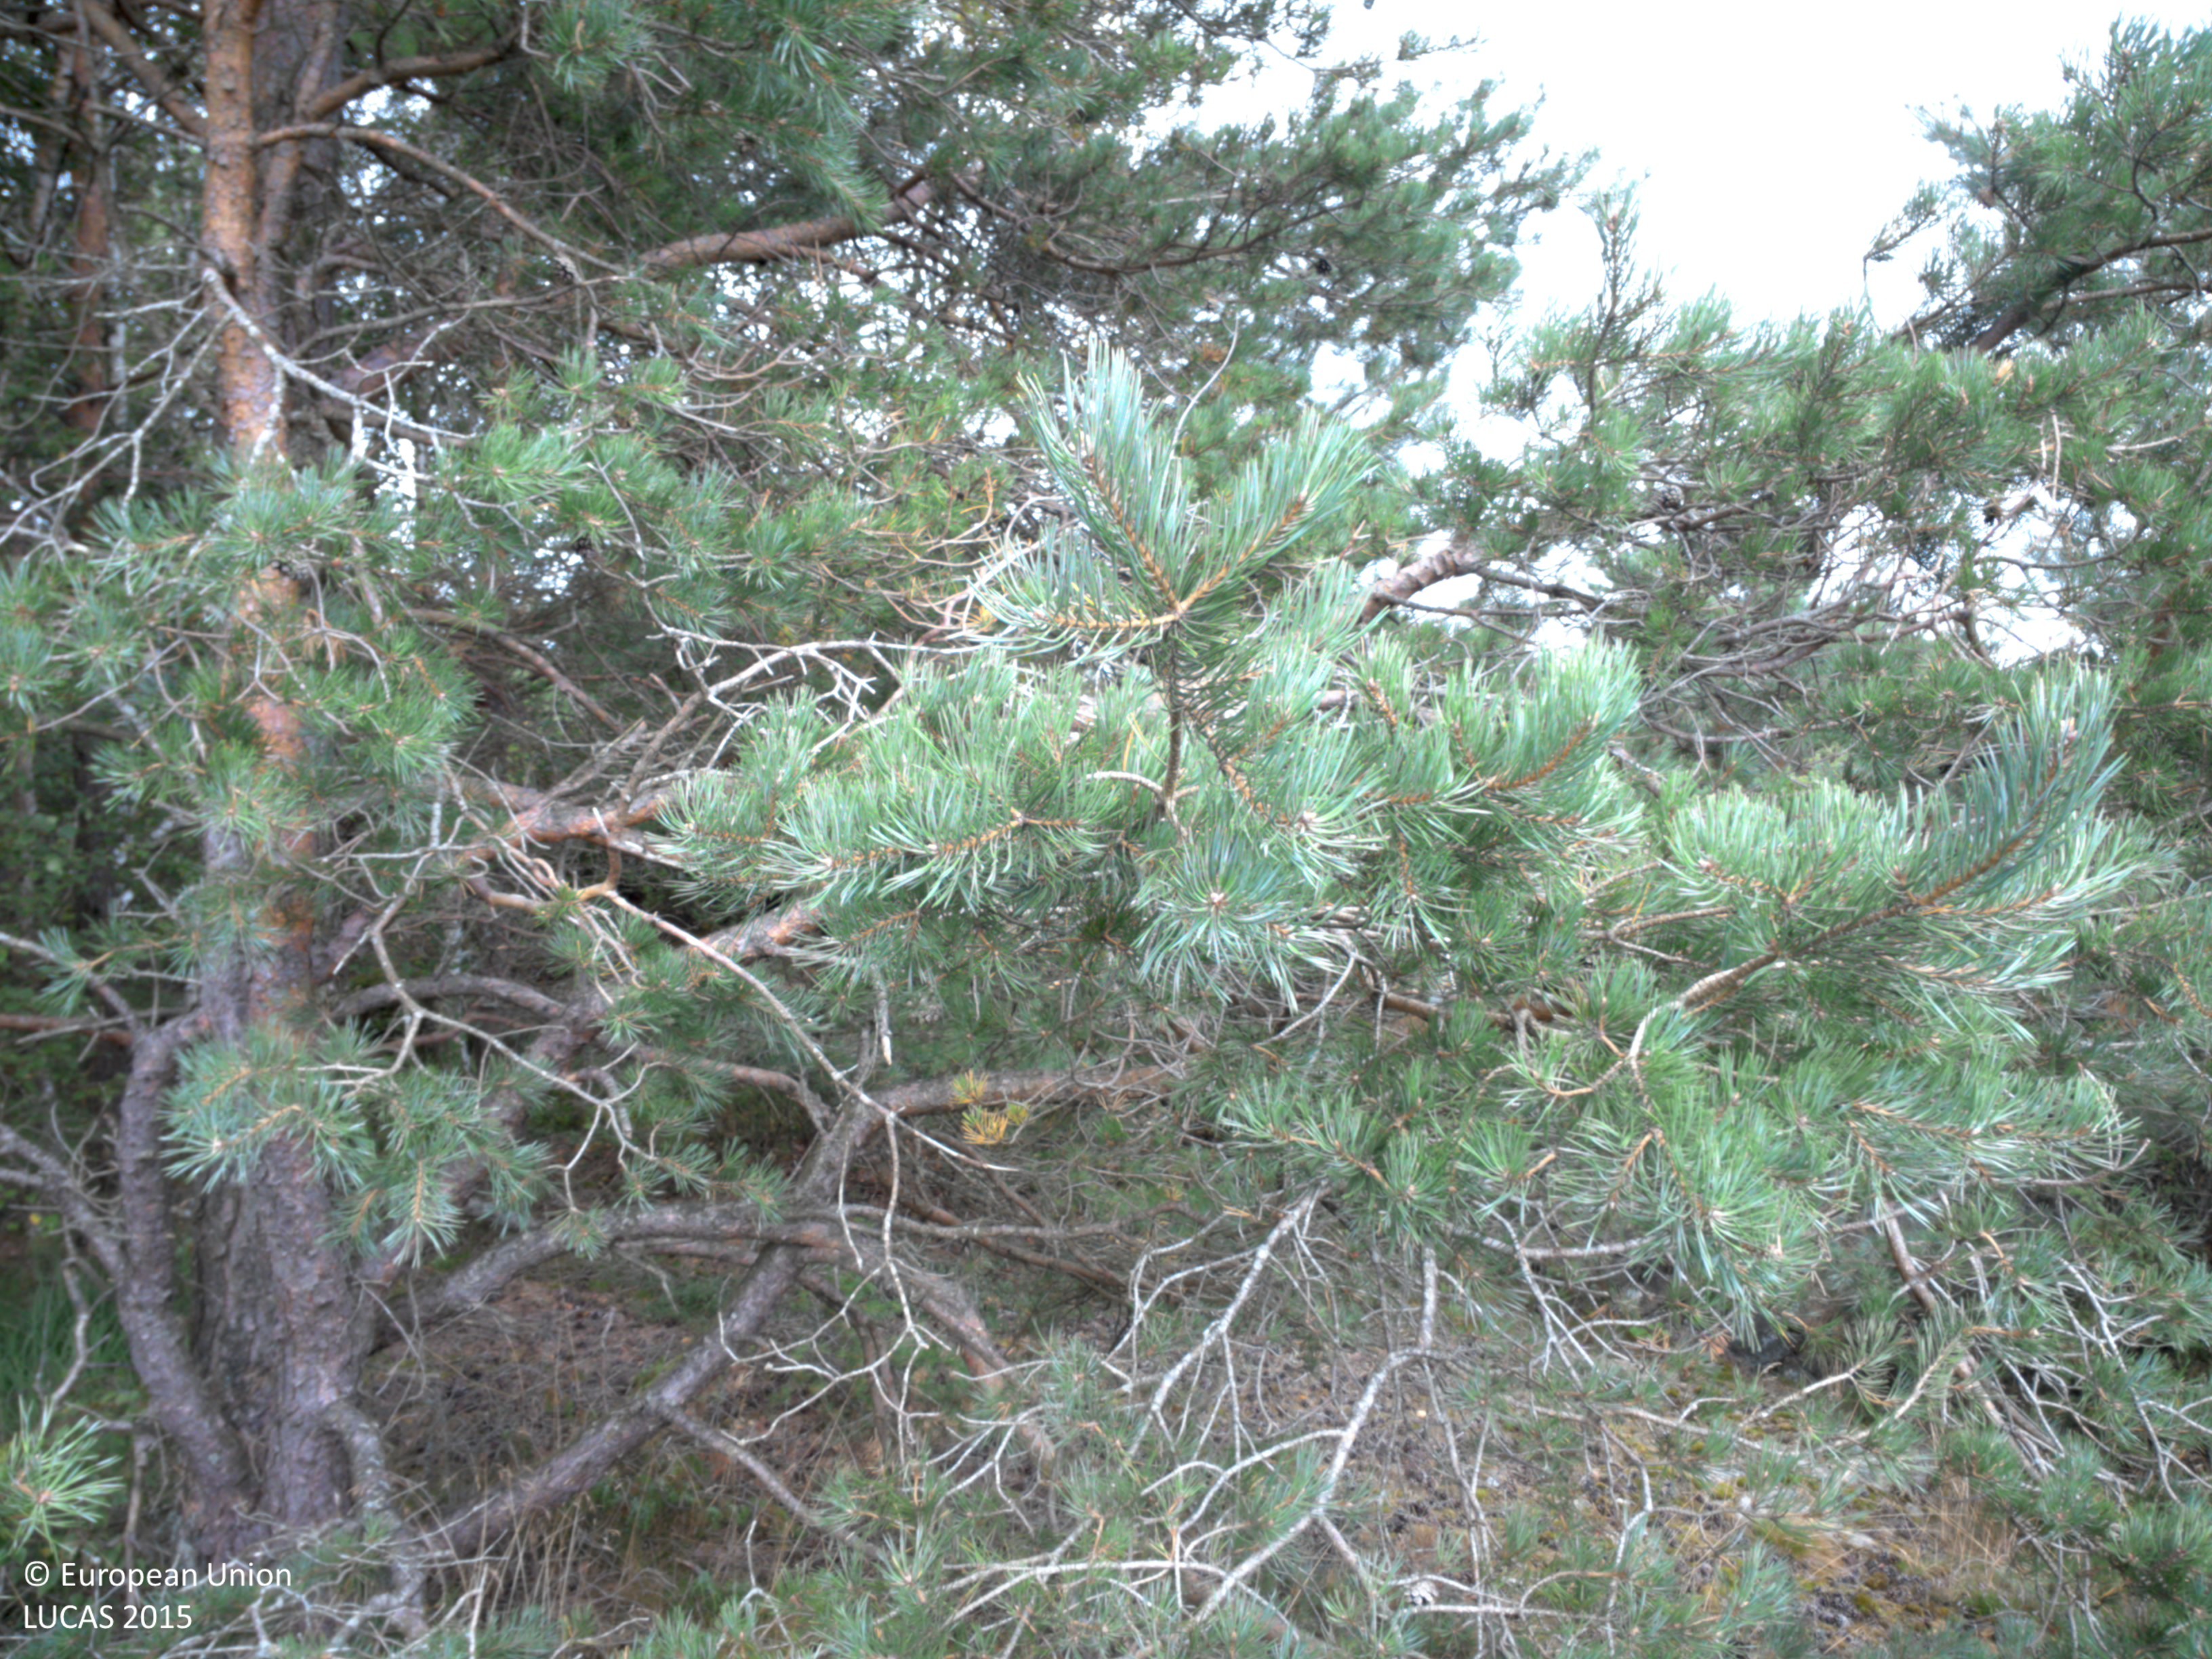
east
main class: Woodland
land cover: Pine dominated coniferous woodland
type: boreal forest
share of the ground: 50 - 75 %
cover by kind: coniferous forest trees 50 %, shrubs 20 %, lichens and mosses 20 %, unconsolidated bare surface 10 %
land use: Forestry
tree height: < 5 m
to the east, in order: Pine dominated coniferous woodland; Lichens and moss; Pine dominated coniferous woodland; Pine dominated mixed woodland; Fences; Broadleaved woodland; Ditches and canals; Paved roads, cycling and walking lanes; Grass margins; Paved roads, cycling and walking lanes; Ditches and canals; Broadleaved woodland; Pine dominated mixed woodland
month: August
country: SE
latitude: 57.9910
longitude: 11.8404
